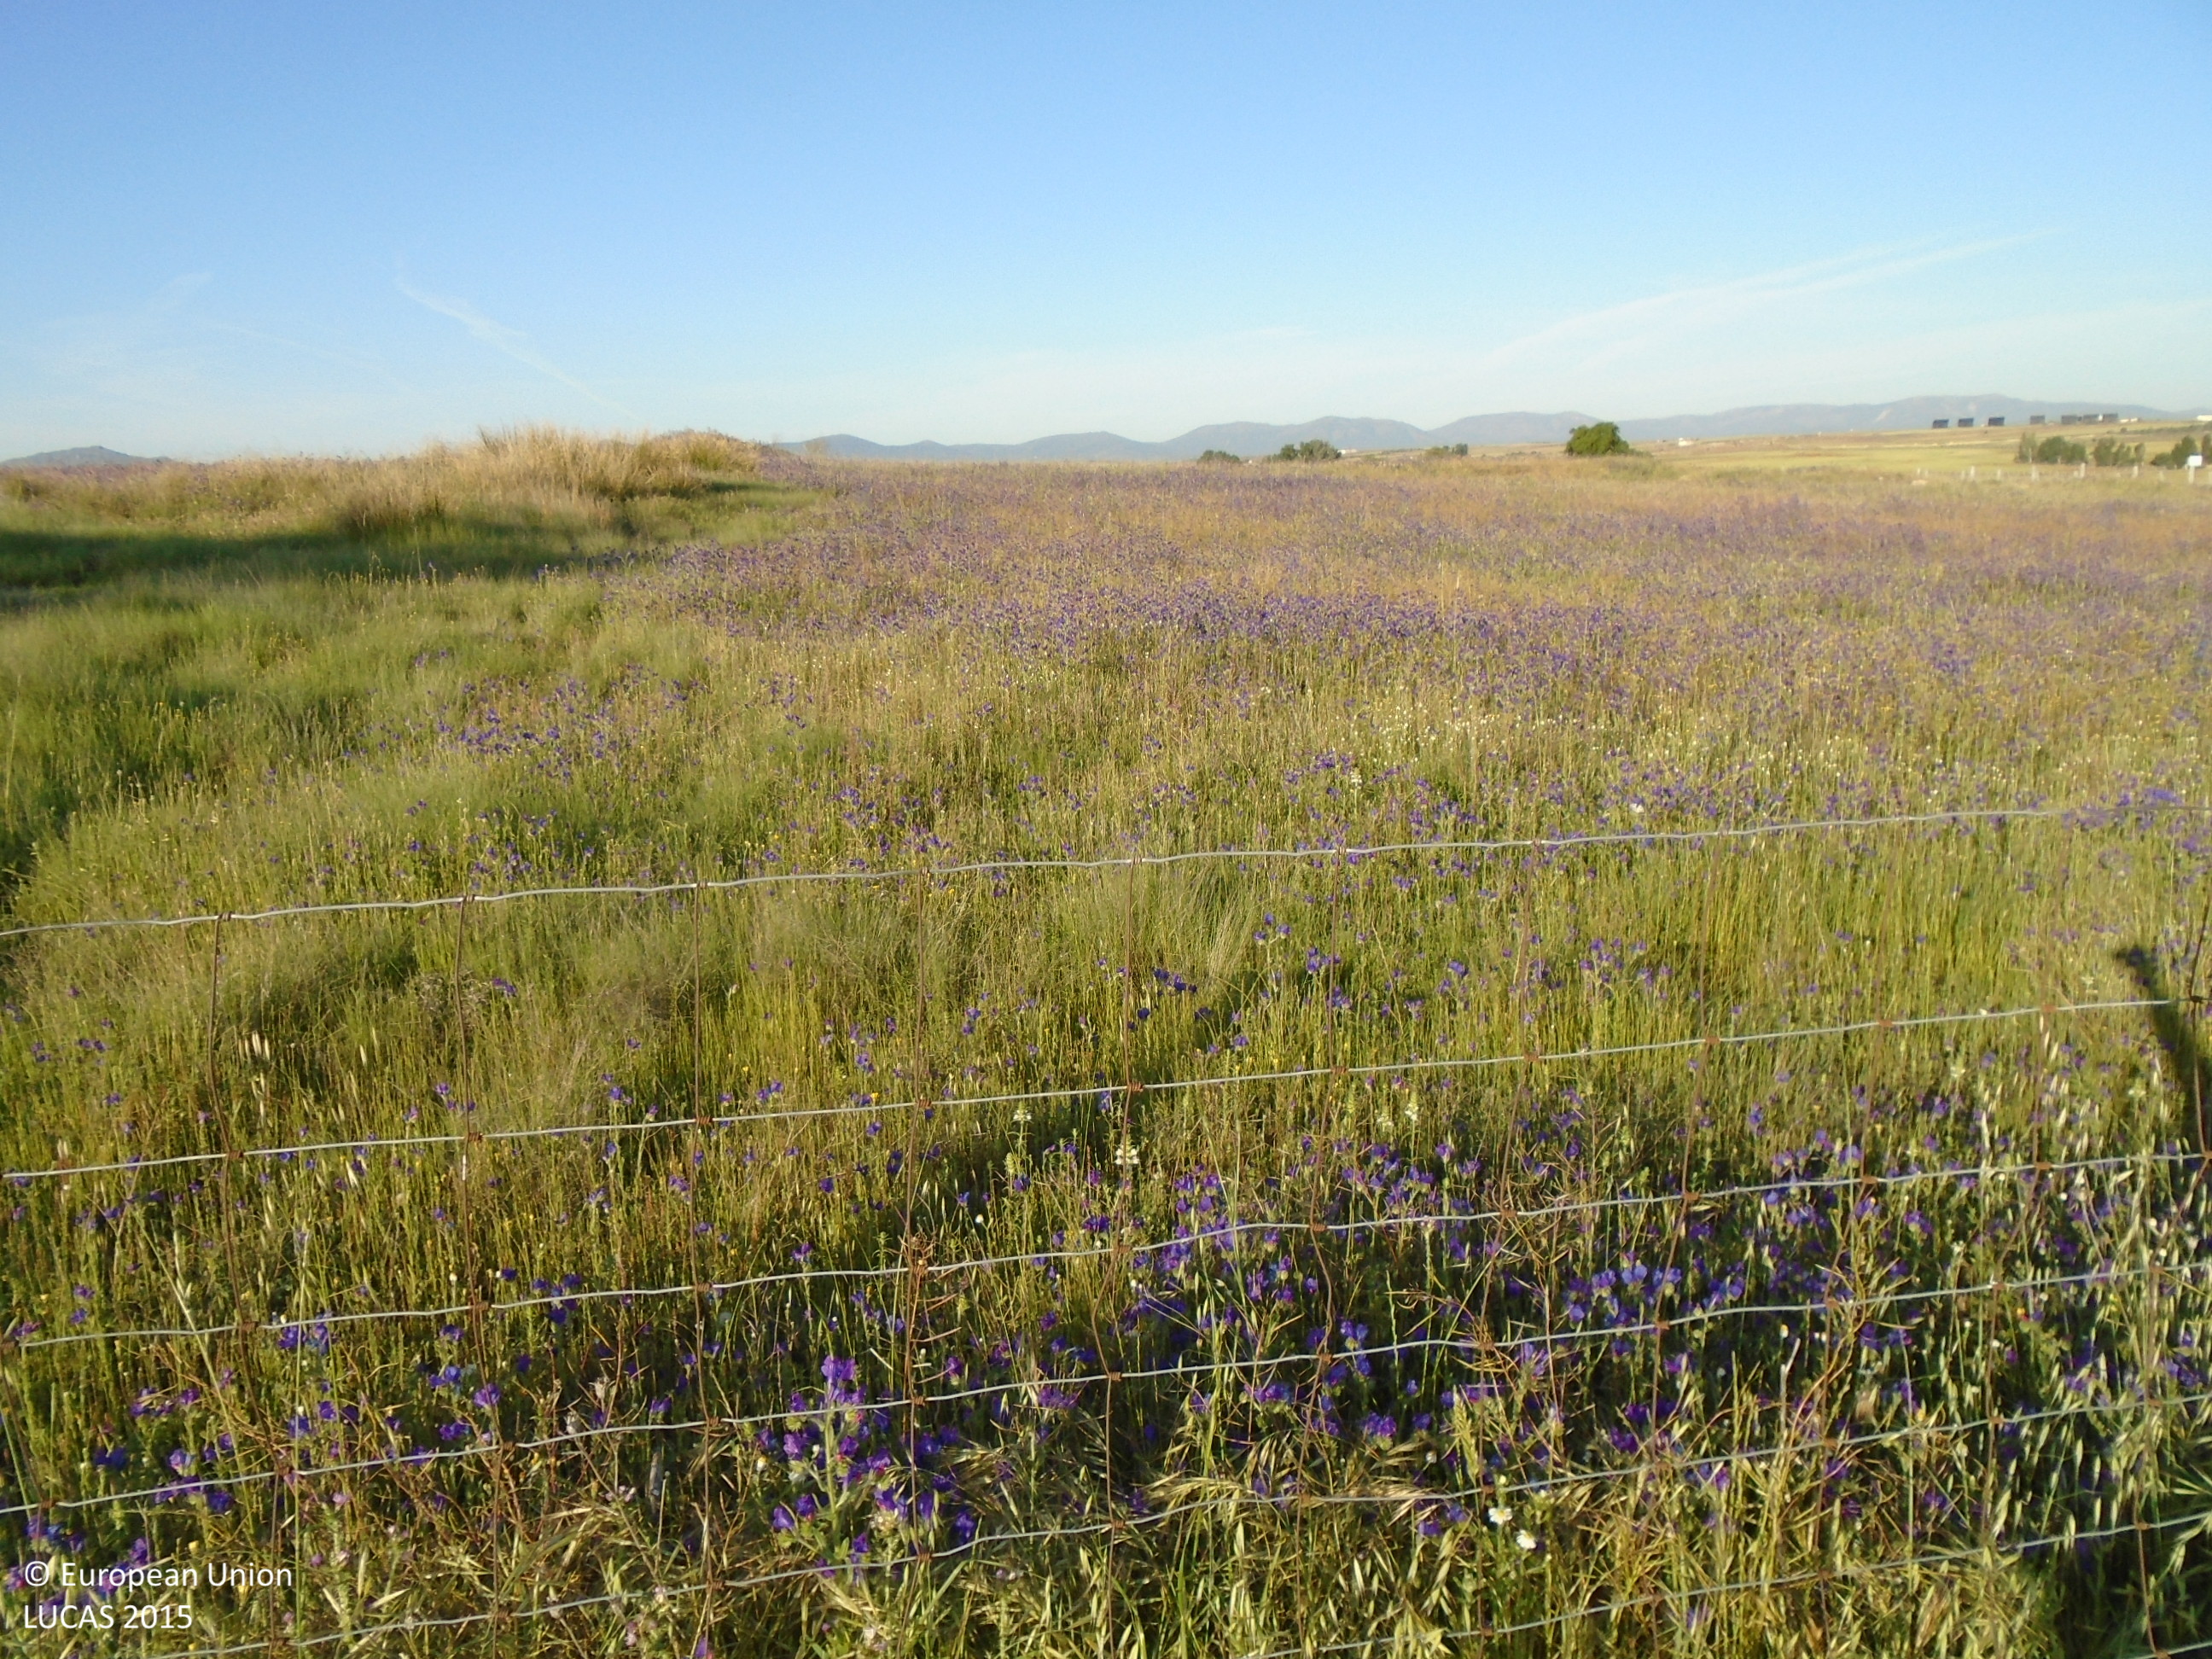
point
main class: Grassland
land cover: Spontaneously vegetated surfaces
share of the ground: > 75 %
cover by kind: herbaceous plants 100 %
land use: Agriculture (excluding fallow land and kitchen gardens)
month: May
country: ES
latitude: 39.6514
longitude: -4.1937
